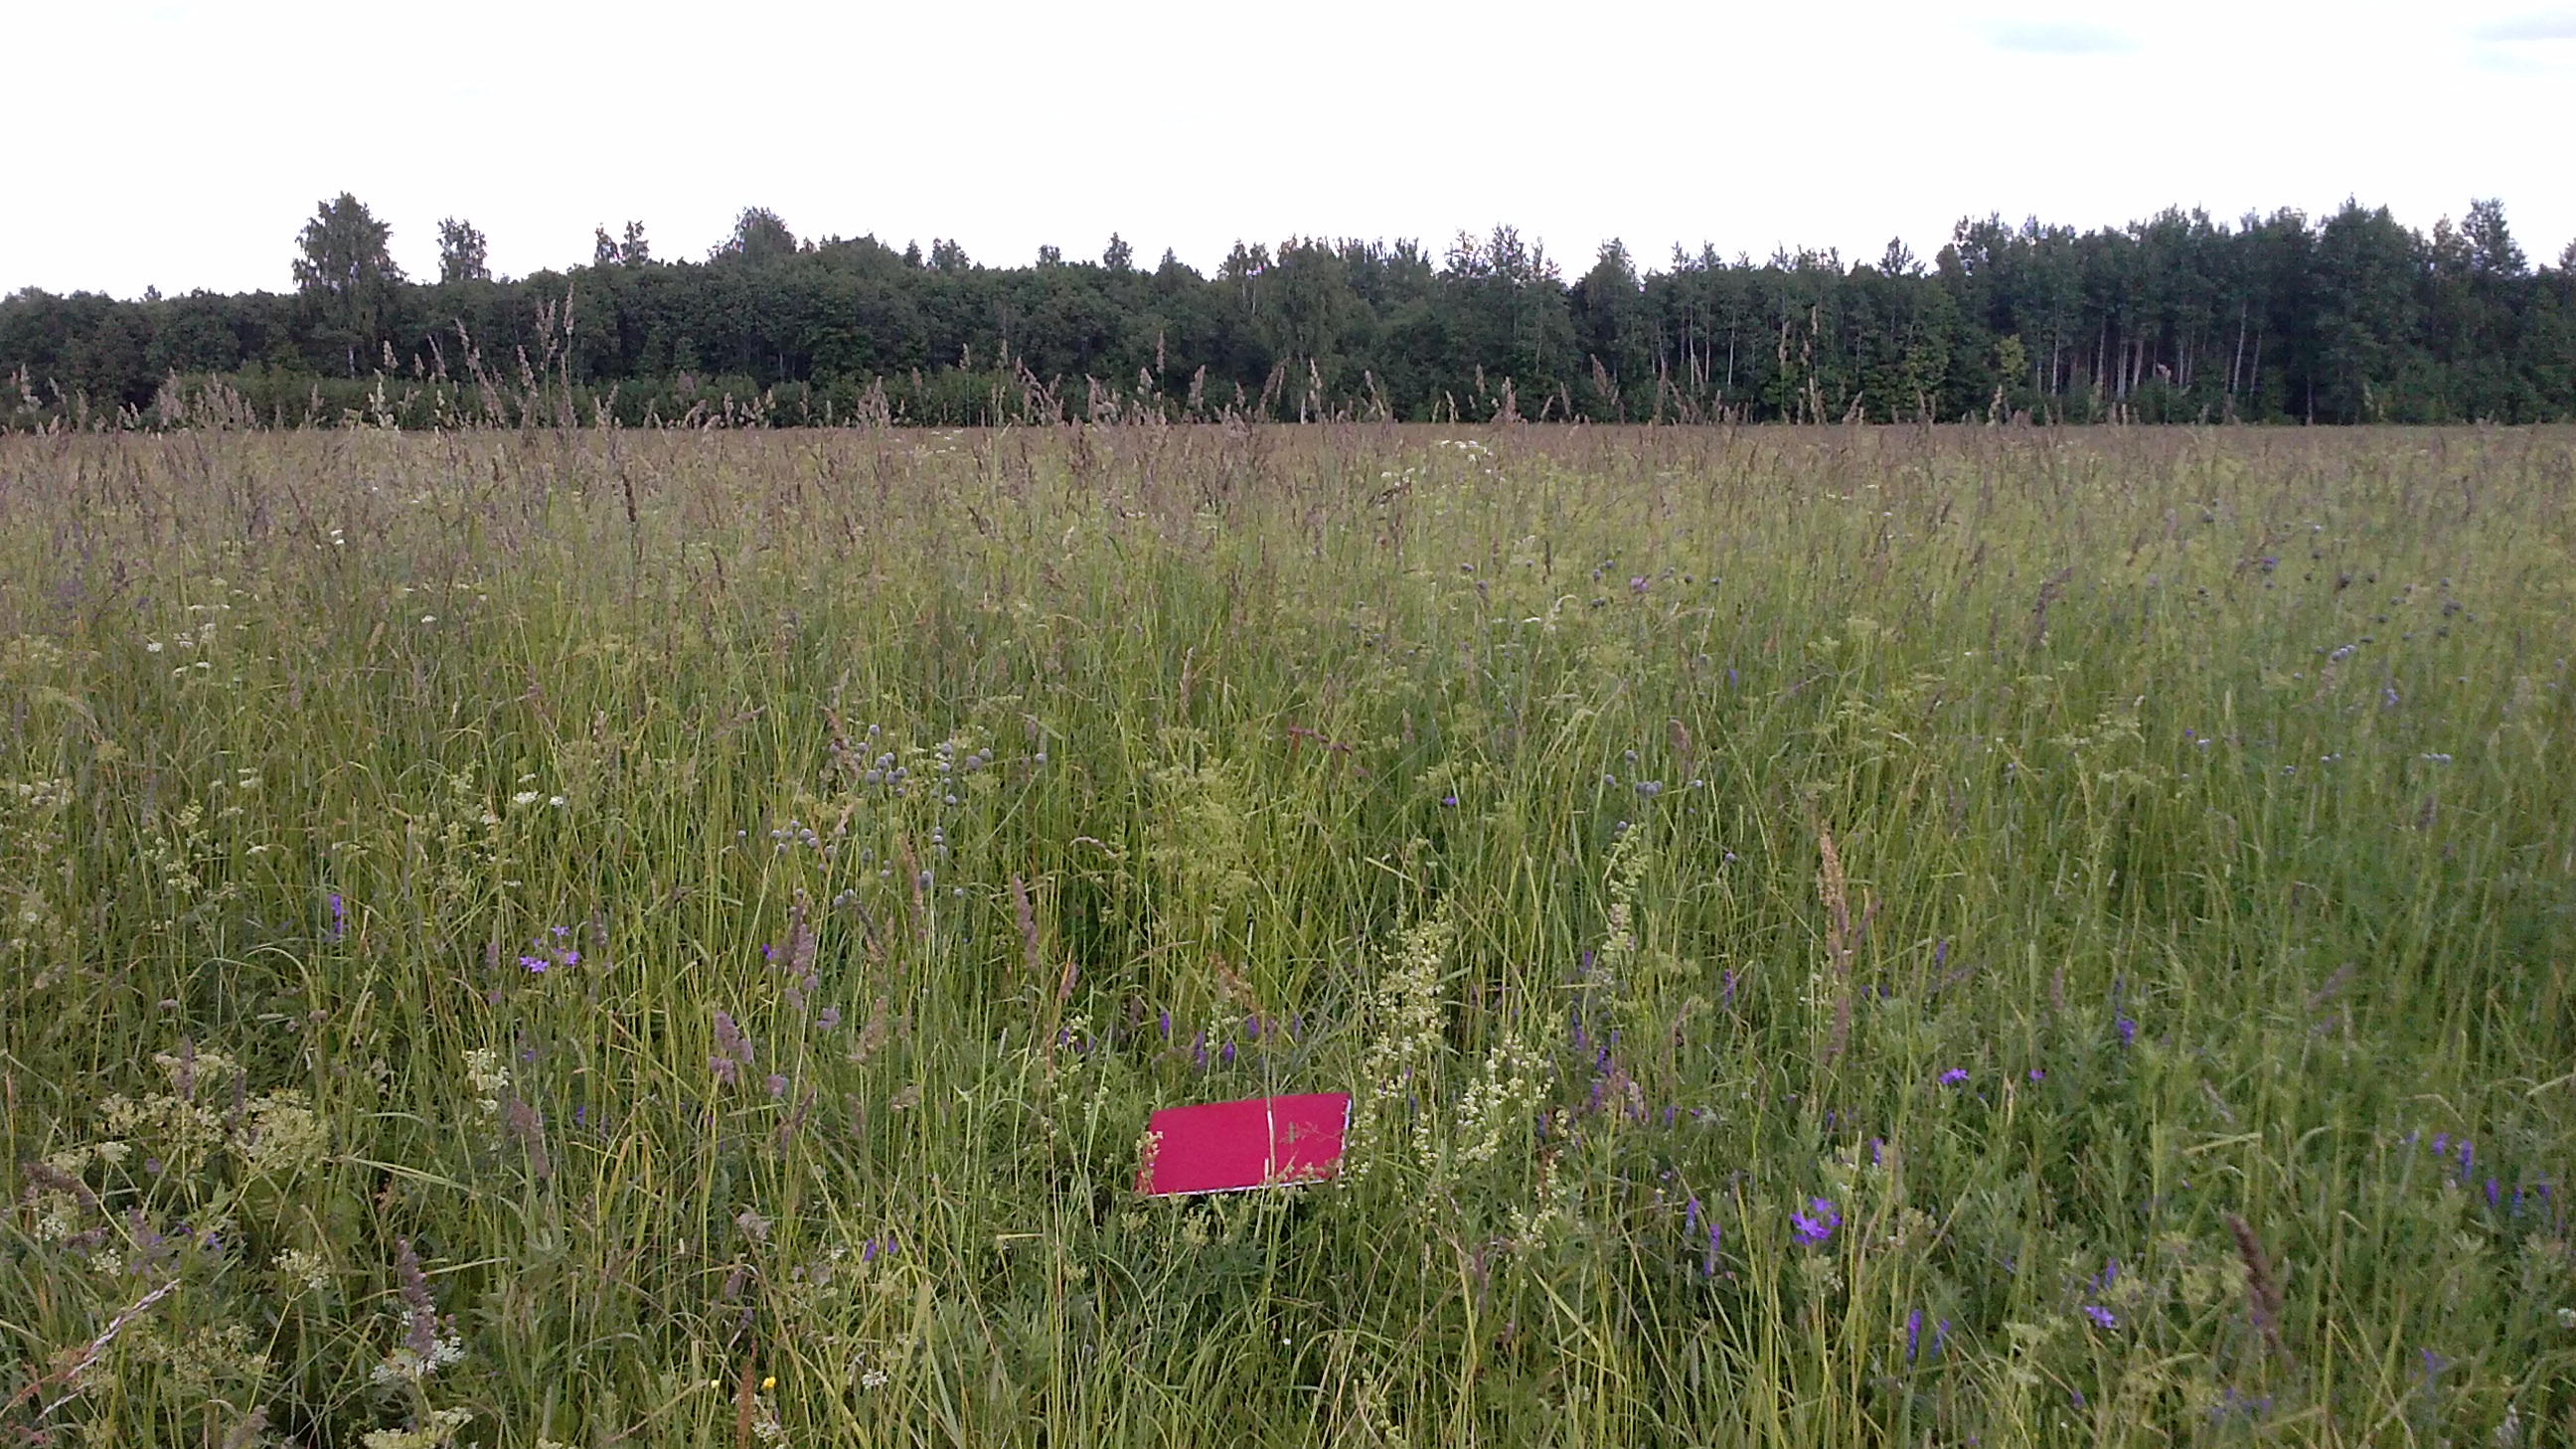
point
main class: Grassland
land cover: Grassland without tree/shrub cover
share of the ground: > 75 %
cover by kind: herbaceous plants 100 %
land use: Agriculture (excluding fallow land and kitchen gardens)
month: June
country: LV
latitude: 56.5389
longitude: 27.9022
